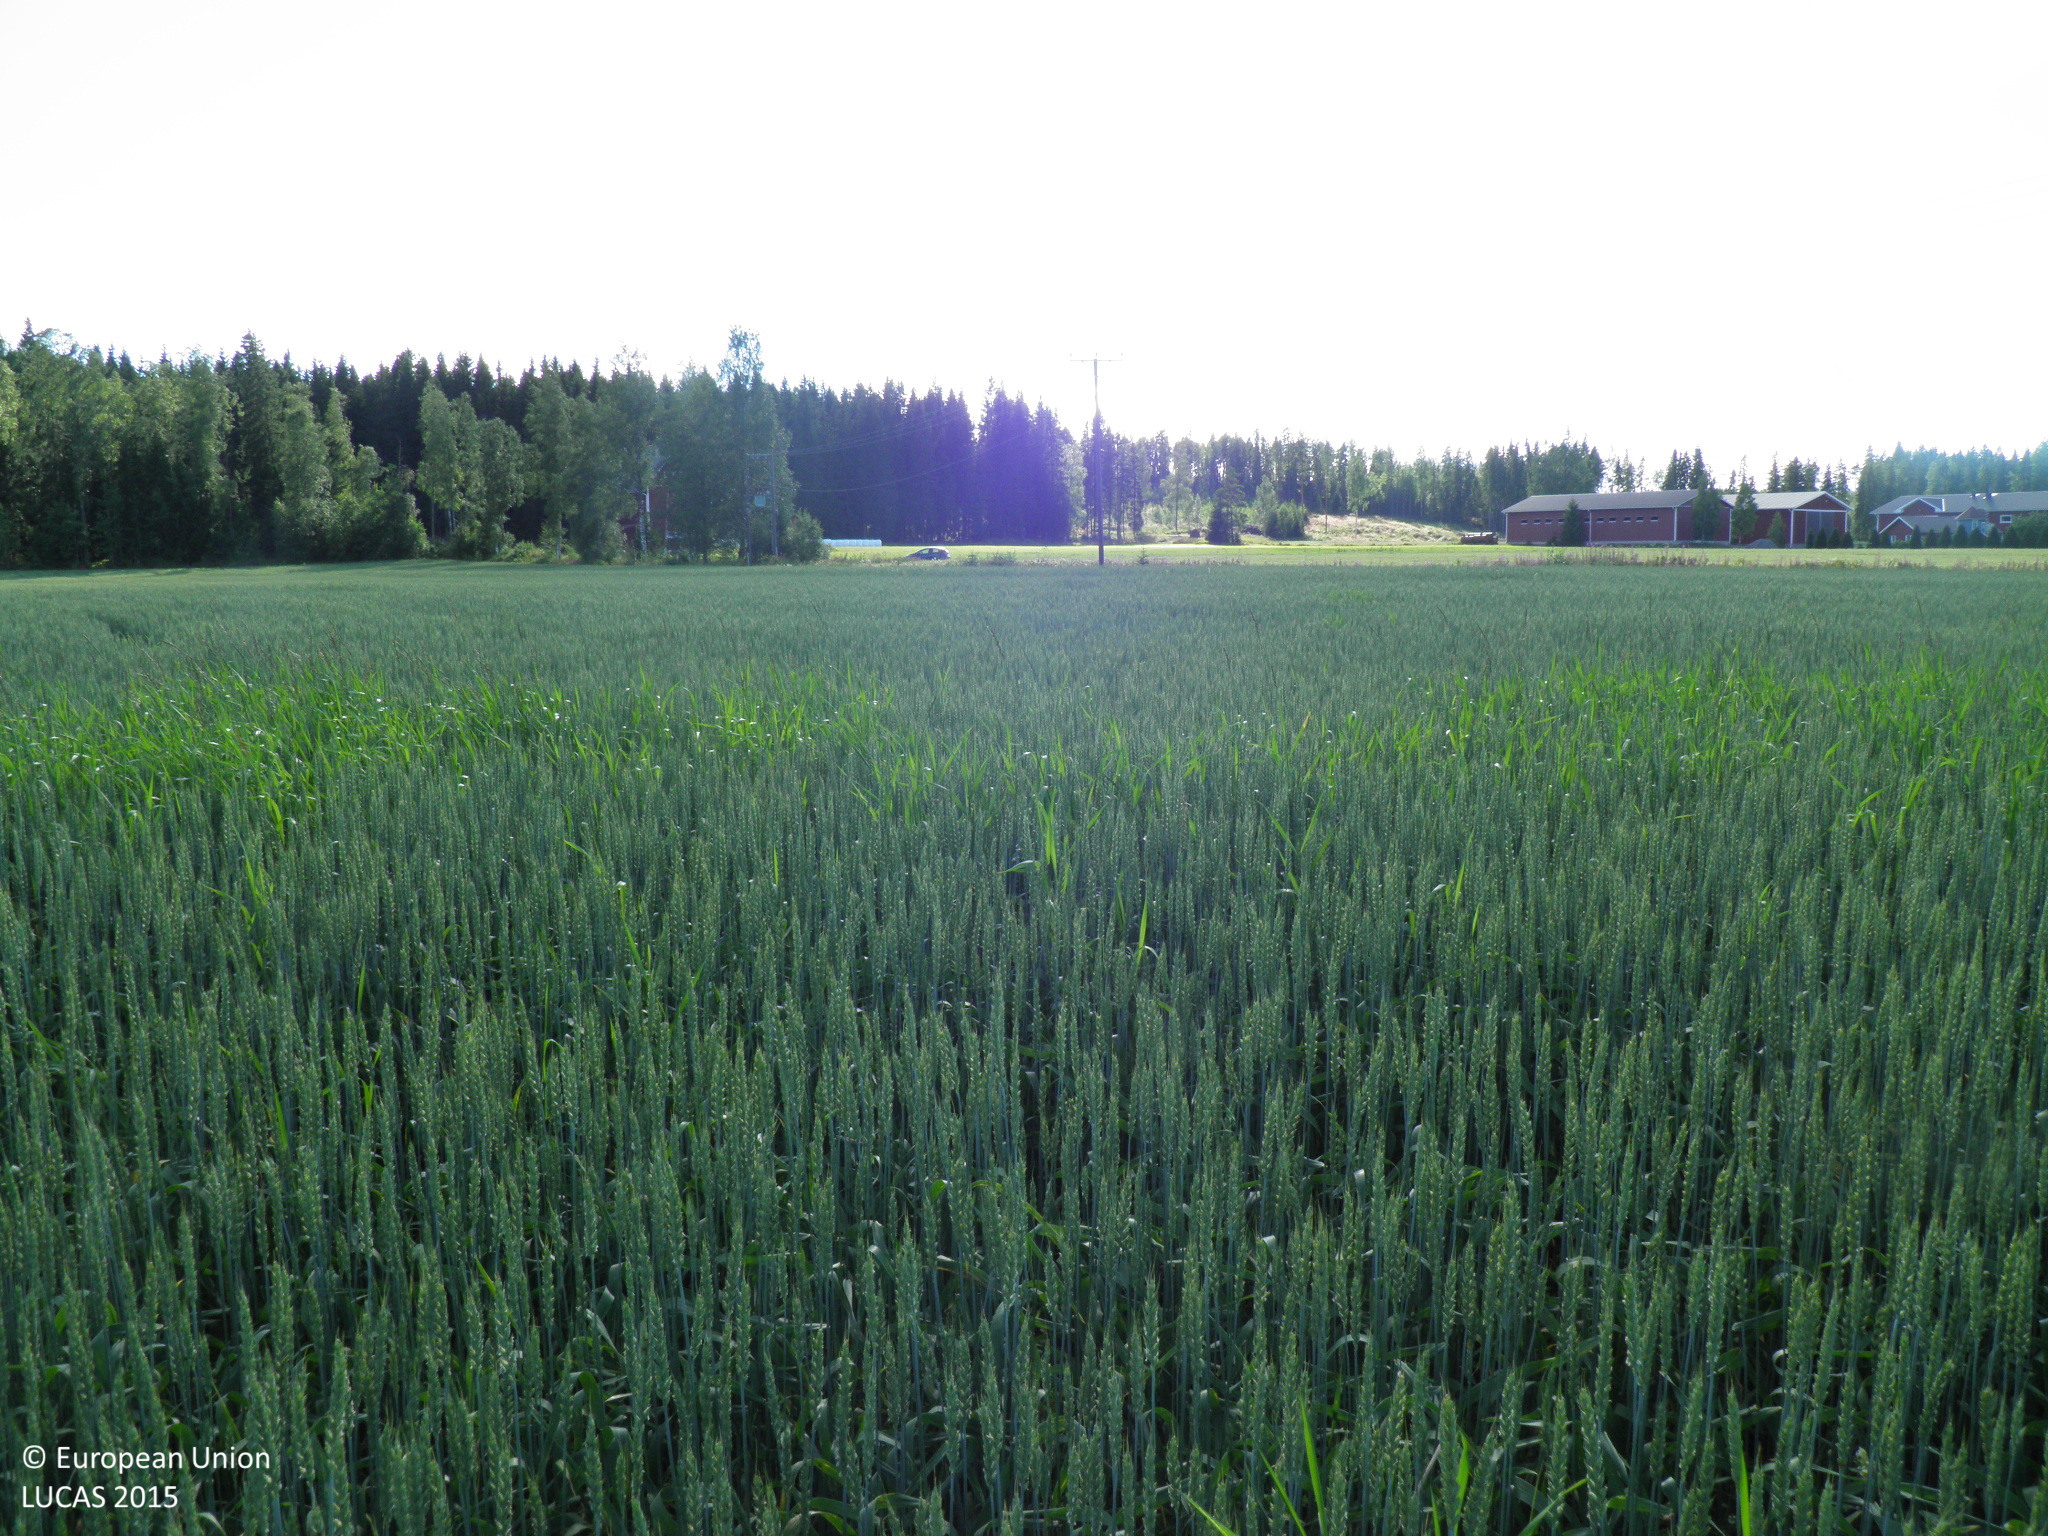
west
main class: Cropland
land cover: Common wheat
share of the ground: > 75 %
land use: Agriculture (excluding fallow land and kitchen gardens)
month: August
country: FI
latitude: 61.0022
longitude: 23.0006
